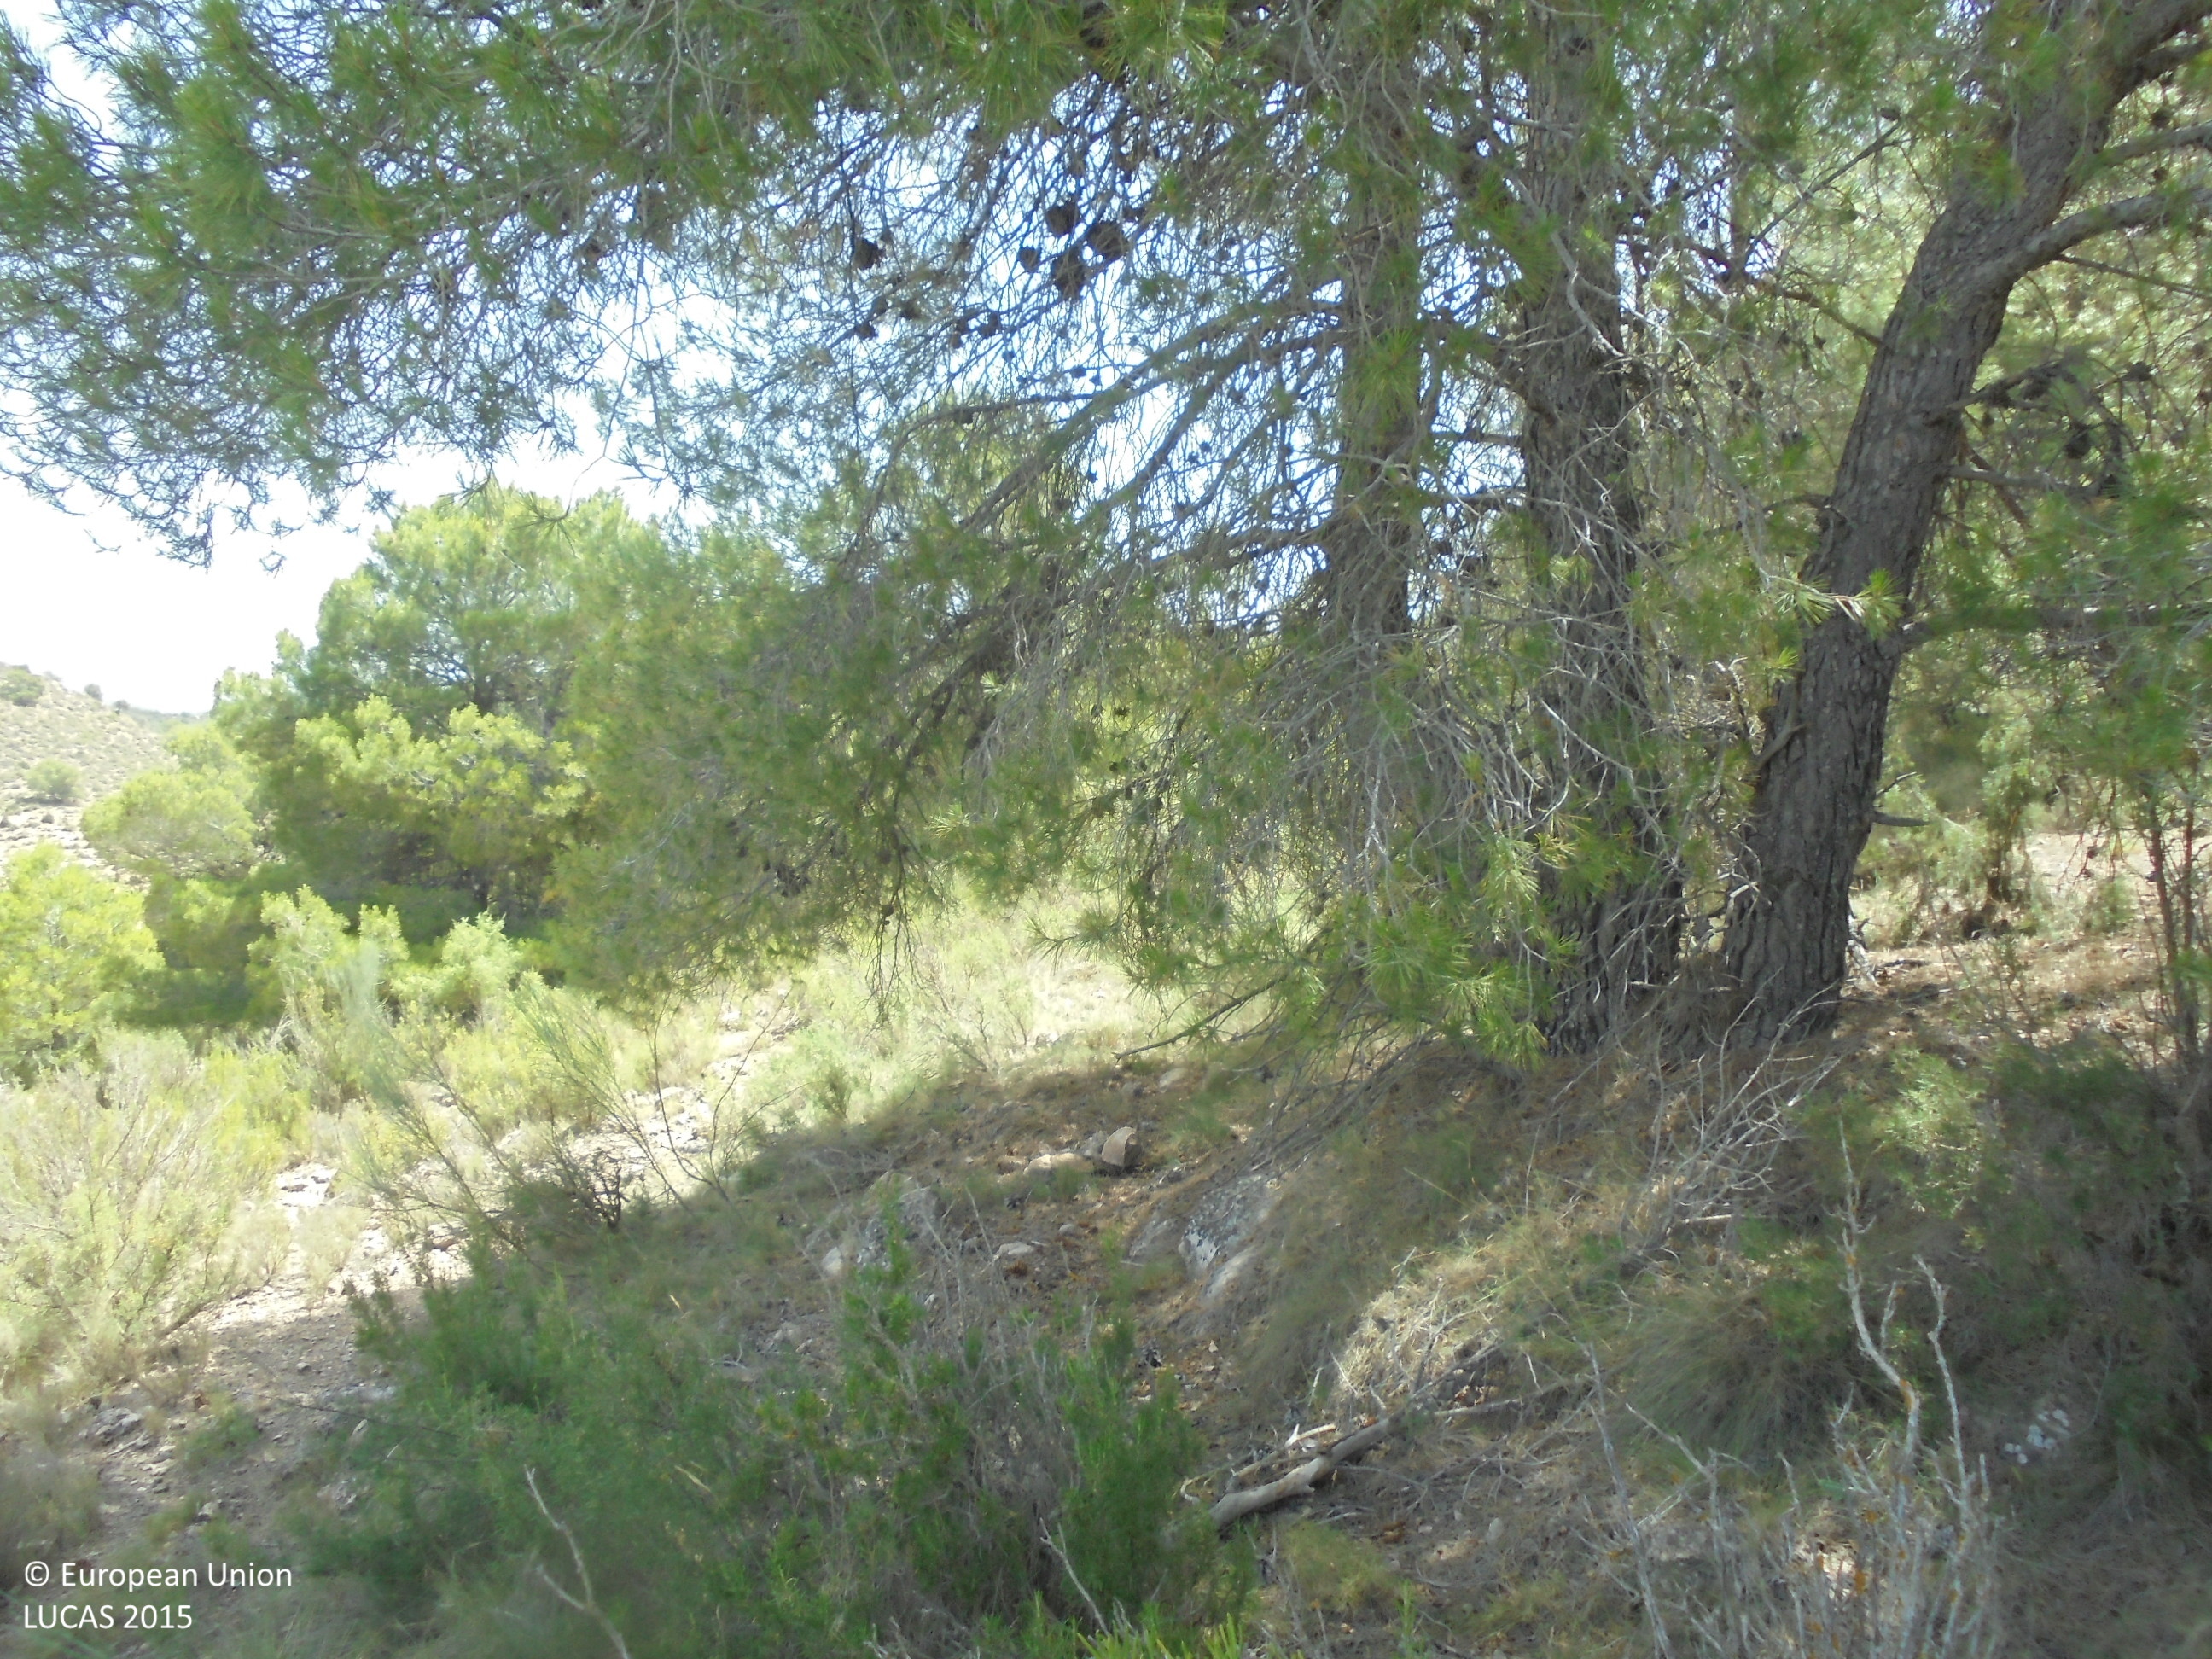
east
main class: Woodland
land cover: Pine dominated coniferous woodland
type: coniferous forest of the mediterranean region
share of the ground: 25 - 50 %
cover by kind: shrubs 50 %, coniferous forest trees 30 %, herbaceous plants 10 %, unconsolidated bare surface 10 %
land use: Semi-natural and natural areas not in use
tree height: > 5 m
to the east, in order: Pine dominated coniferous woodland
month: July
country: ES
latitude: 38.6506
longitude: -1.7038
